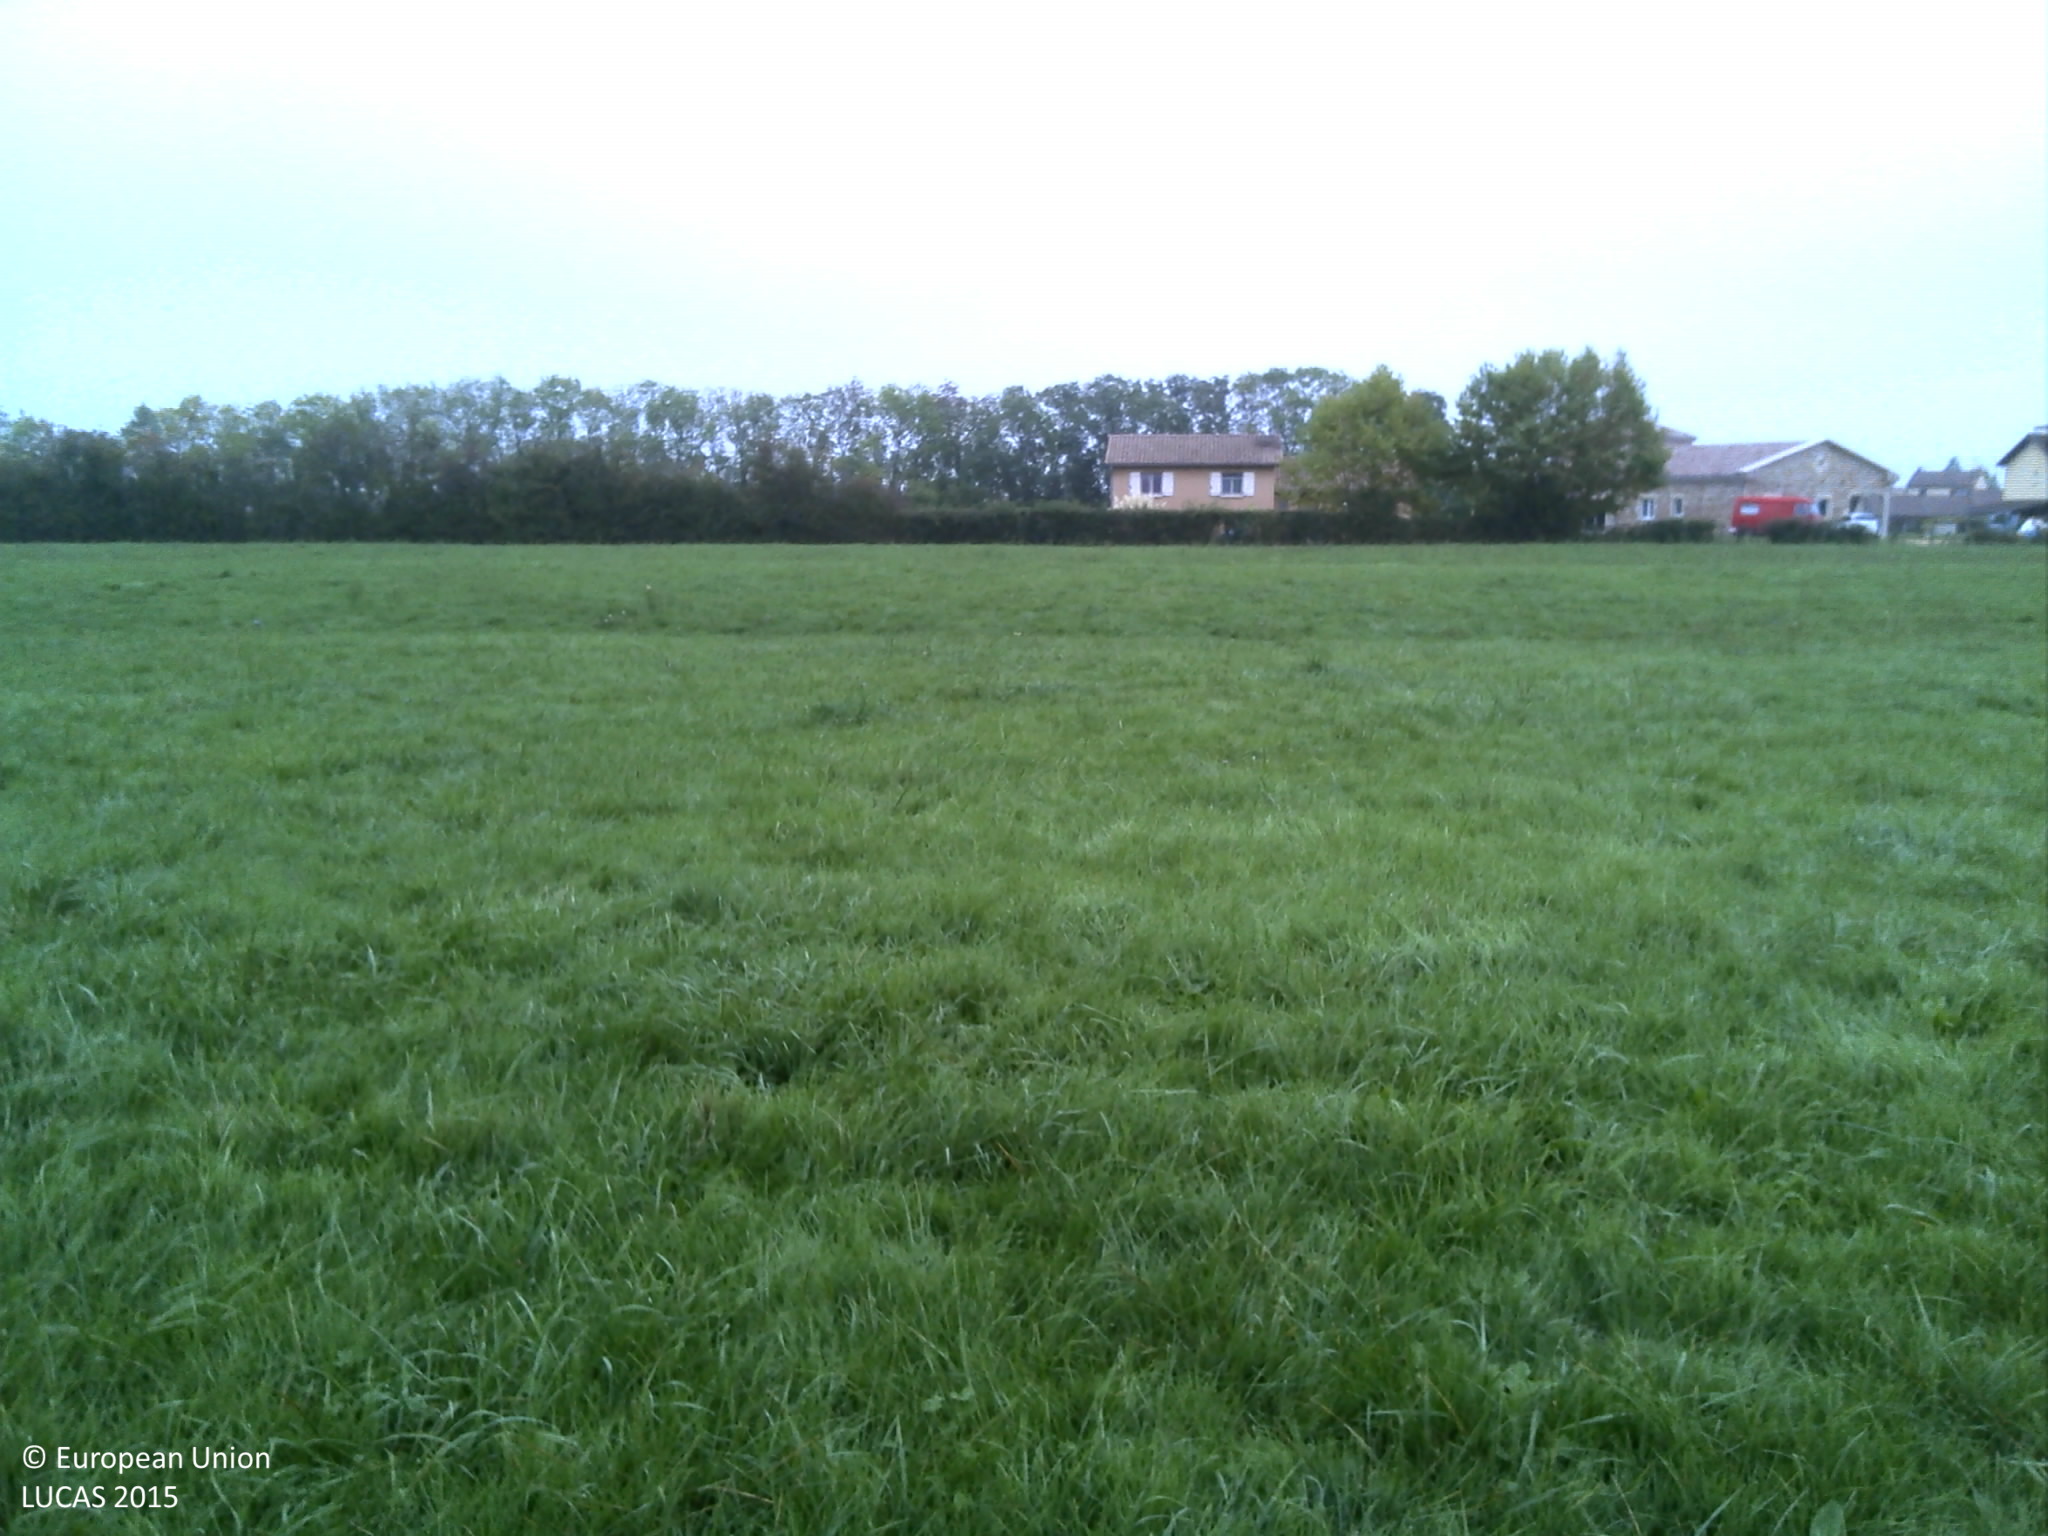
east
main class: Grassland
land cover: Grassland without tree/shrub cover
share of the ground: > 75 %
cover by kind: herbaceous plants 100 %
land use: Agriculture (excluding fallow land and kitchen gardens)
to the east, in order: Grassland without tree/shrub cover; Fences; Abandoned hedges; Grassland without tree/shrub cover; Broadleaved woodland; Fences; Broadleaved woodland; Rape and turnip rape
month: October
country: FR
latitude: 46.4263
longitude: 4.8621
